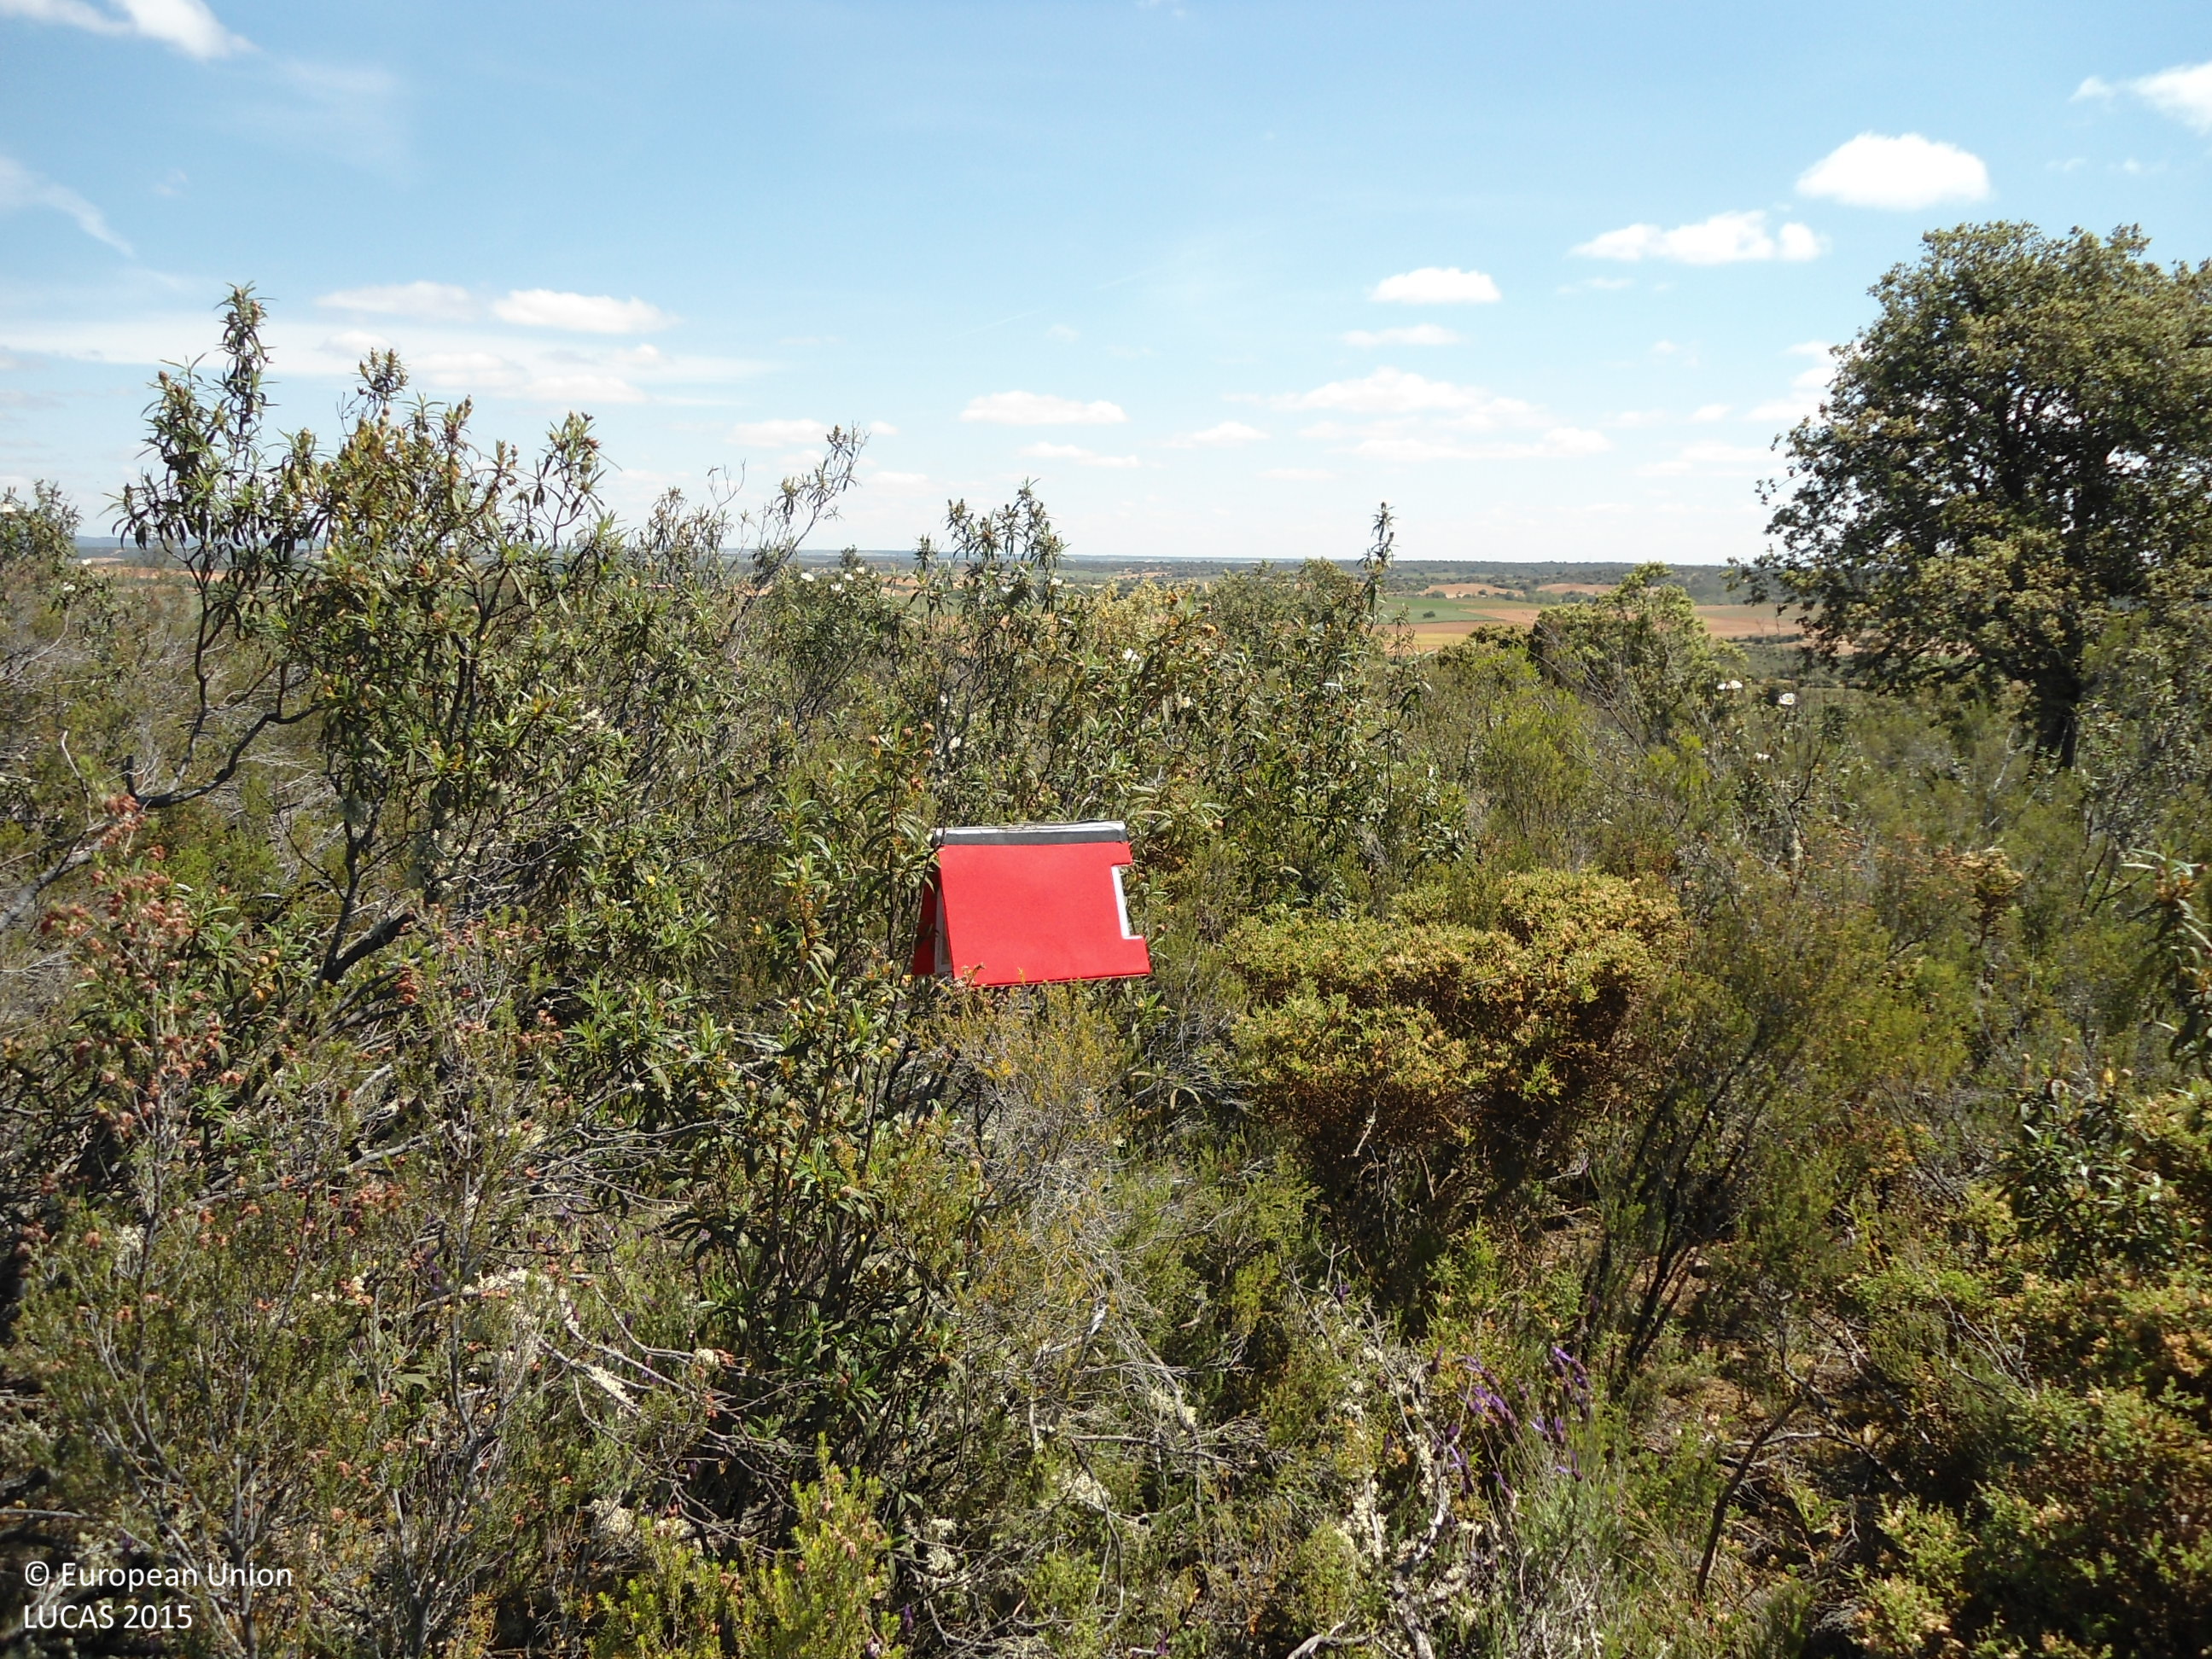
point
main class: Shrubland
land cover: Shrubland with sparse tree cover
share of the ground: > 75 %
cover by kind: shrubs 95 %, broadleaved forest trees 5 %
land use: Semi-natural and natural areas not in use
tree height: < 5 m
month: May
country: ES
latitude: 41.8995
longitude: -5.9223
